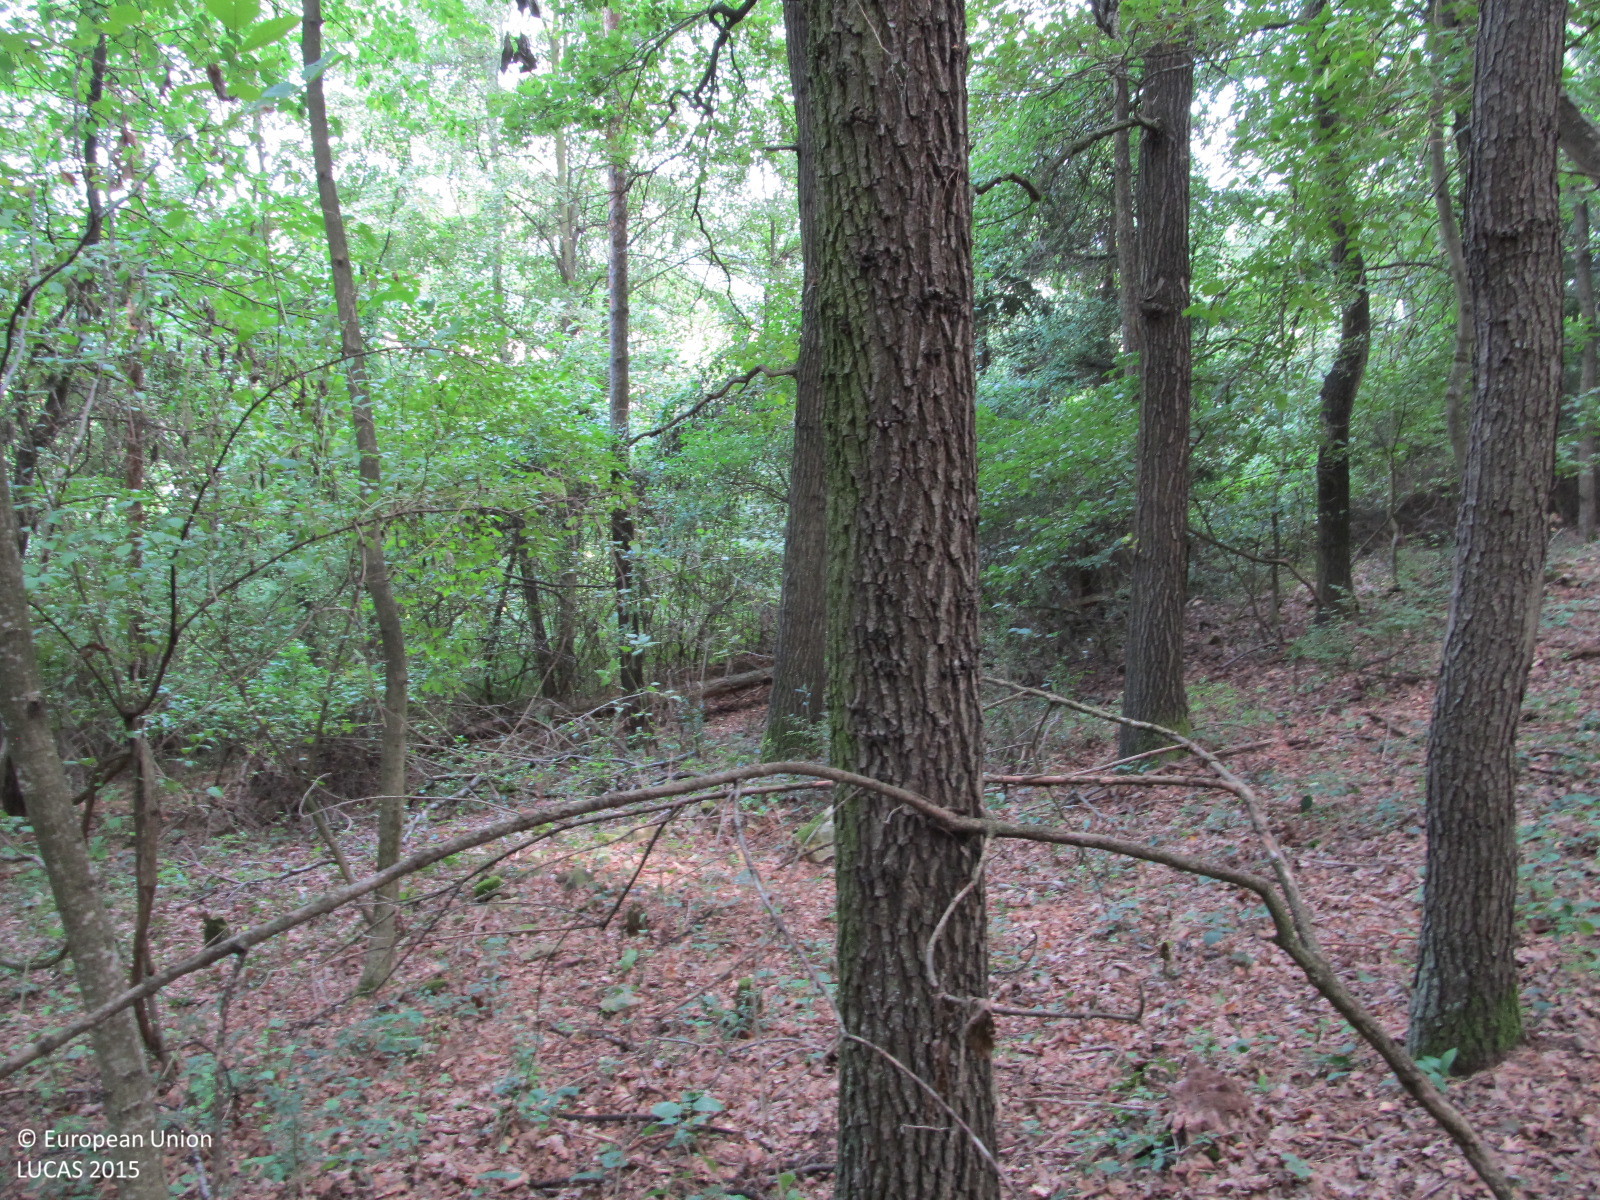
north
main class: Woodland
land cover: Other mixed woodland
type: hemiboreal forest and nemoral coniferous forest and mixed broadleaved-coniferous forest
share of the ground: > 75 %
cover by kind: broadleaved forest trees 60 %, coniferous forest trees 20 %, herbaceous plants 10 %, unconsolidated bare surface 10 %
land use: Forestry
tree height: > 5 m
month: September
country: AT
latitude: 48.3323
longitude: 15.6279
